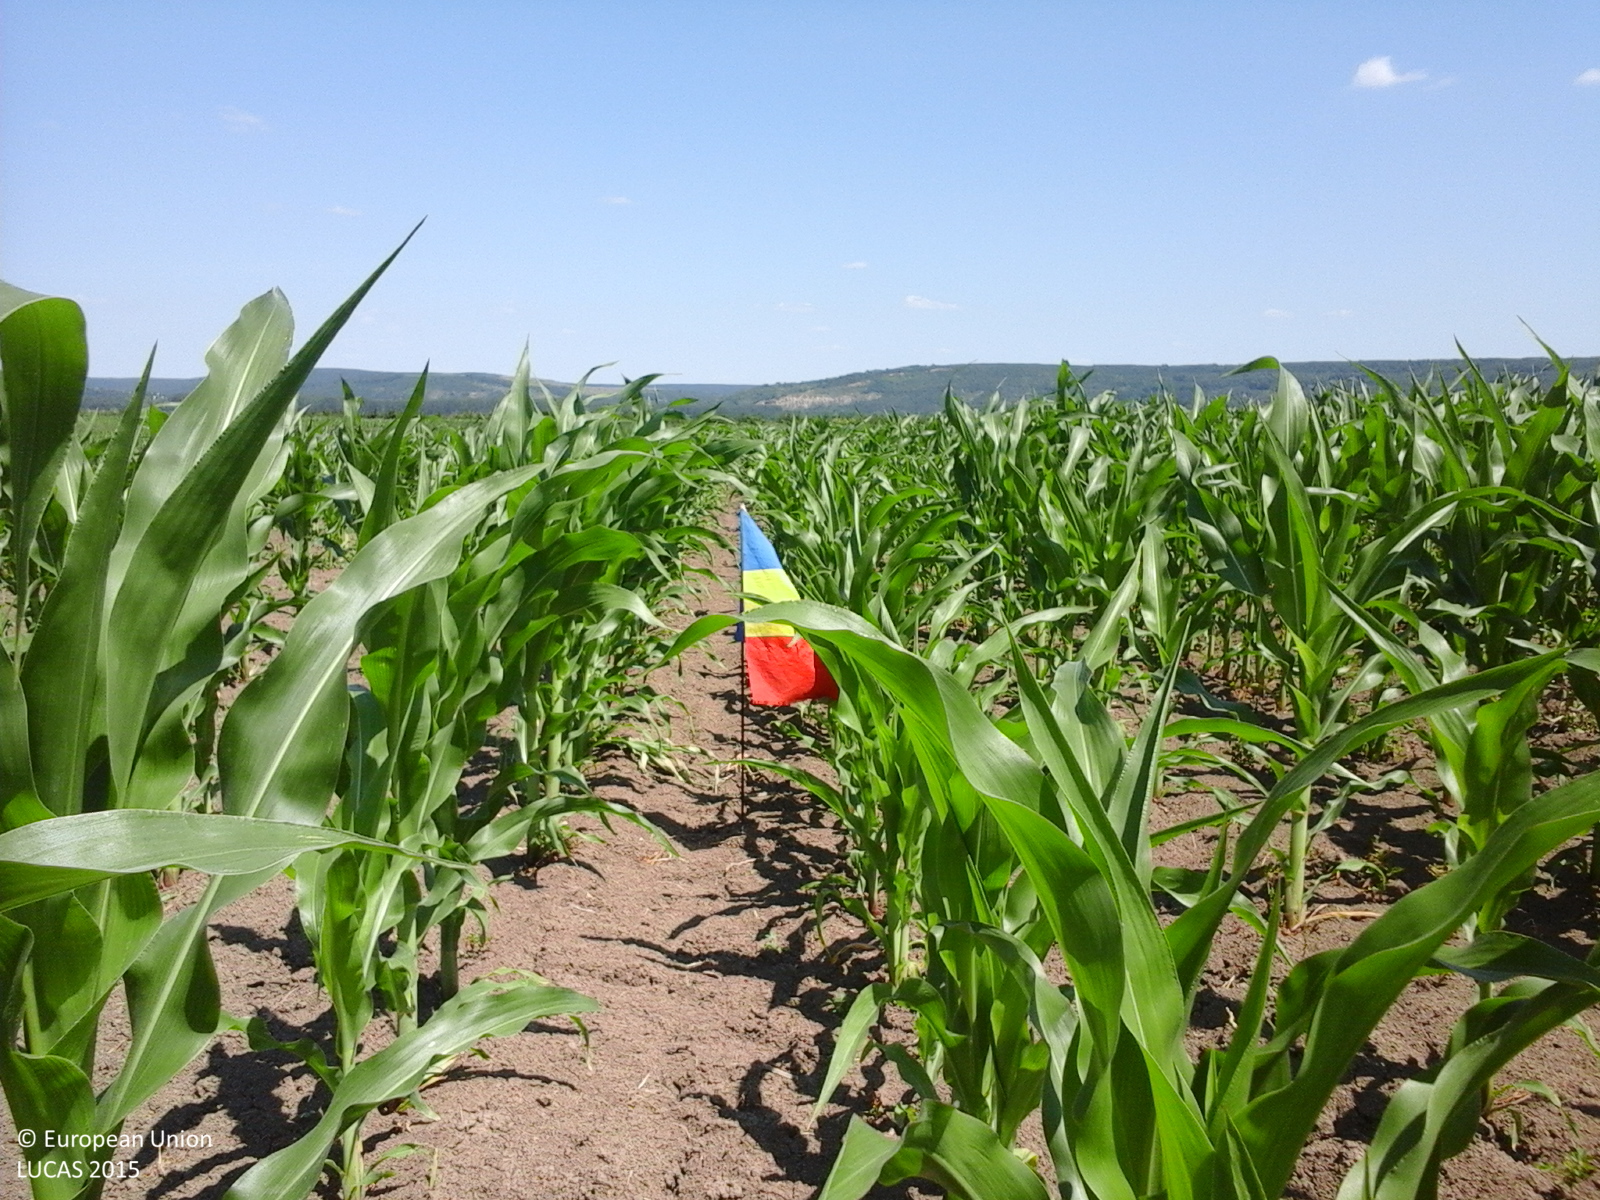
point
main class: Cropland
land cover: Maize
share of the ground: 50 - 75 %
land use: Agriculture (excluding fallow land and kitchen gardens)
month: June
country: RO
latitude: 47.4481
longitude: 27.5321
